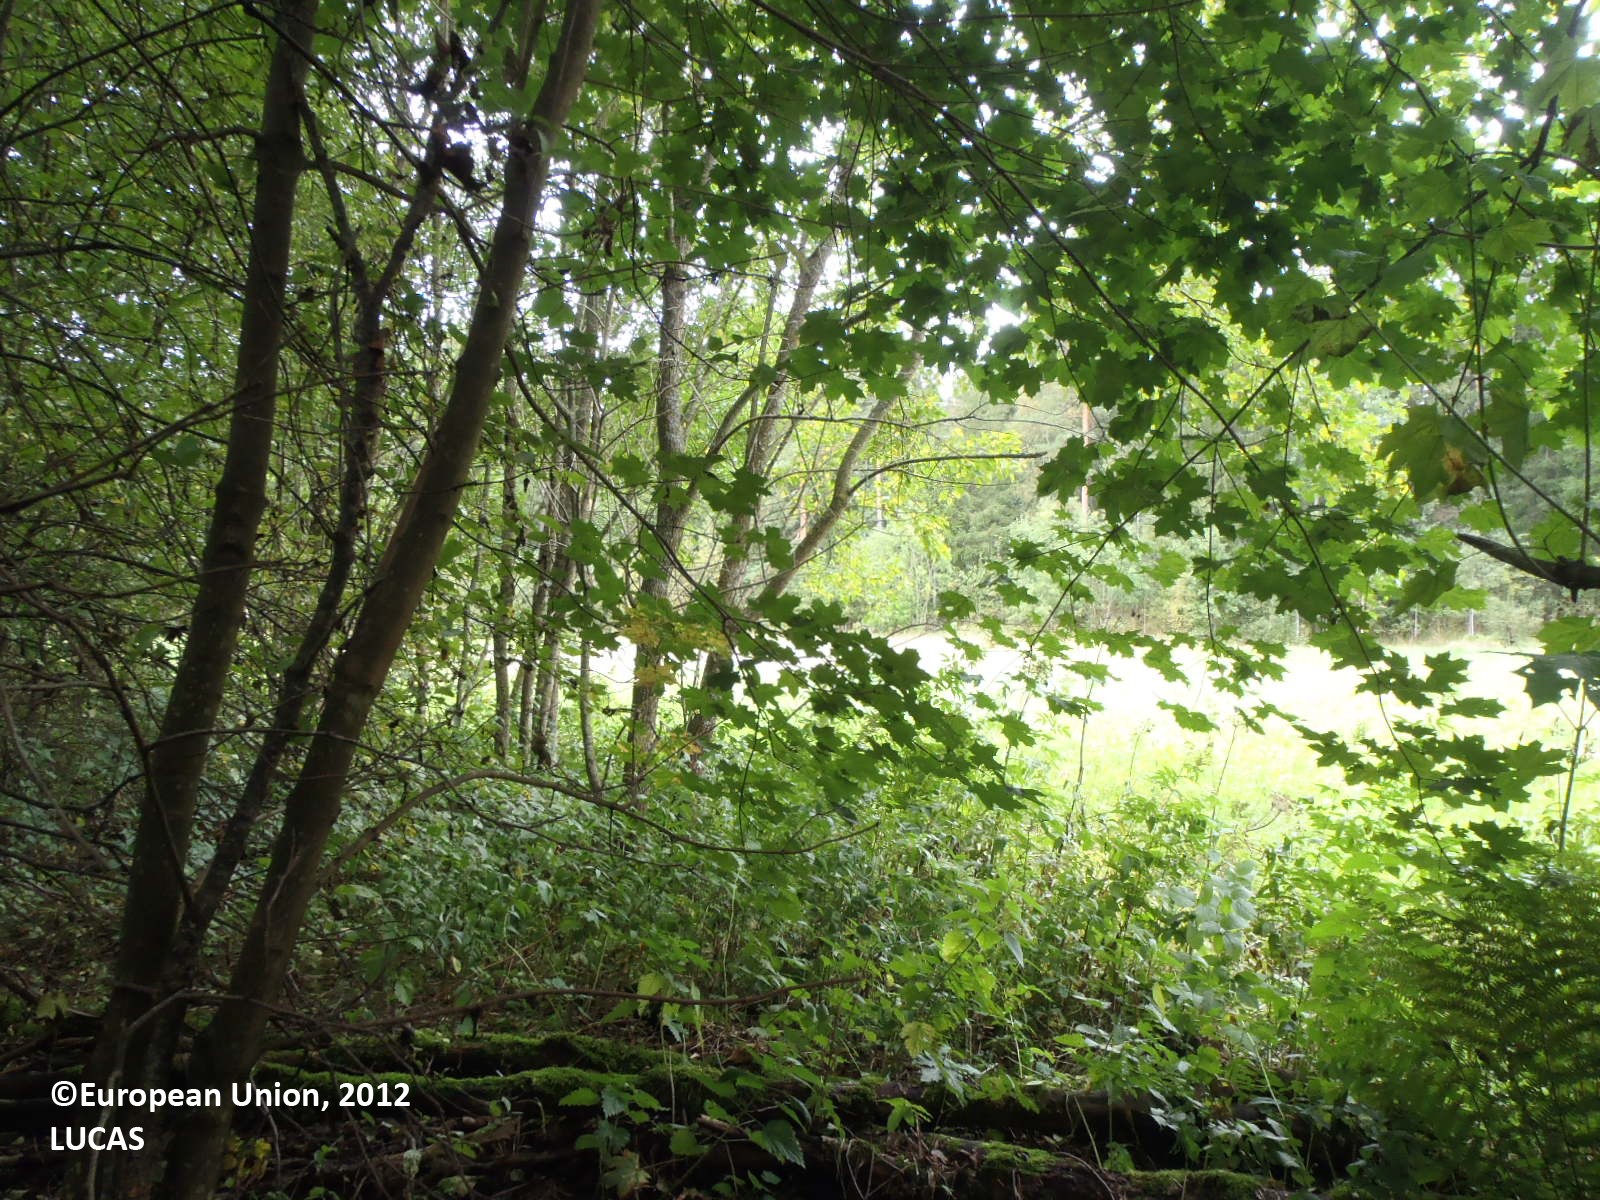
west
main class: Woodland
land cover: Spruce dominated coniferous woodland
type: boreal forest
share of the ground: > 75 %
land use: Forestry
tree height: > 5 m
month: August
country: FI
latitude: 60.7161
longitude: 21.8815
